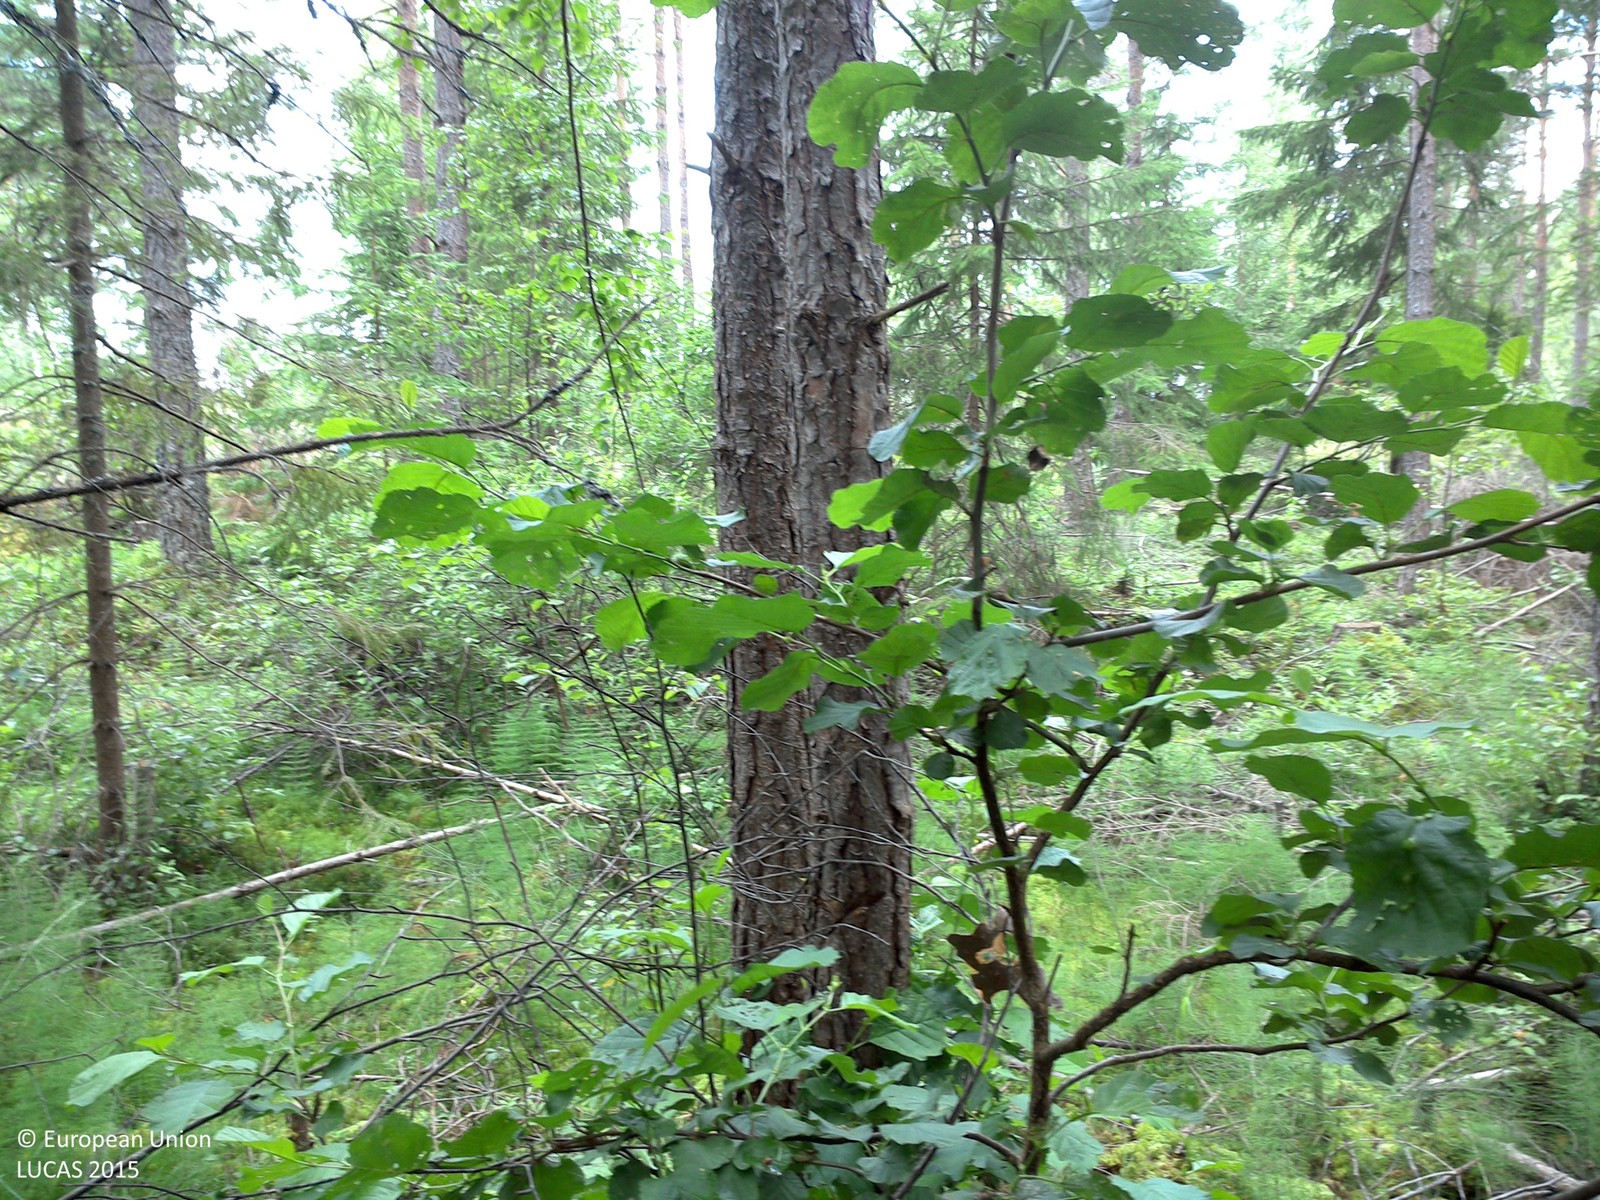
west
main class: Woodland
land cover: Broadleaved woodland
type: mire and swamp forests
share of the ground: 50 - 75 %
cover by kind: broadleaved forest trees 60 %, herbaceous plants 40 %
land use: Forestry
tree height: > 5 m
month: July
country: SE
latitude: 57.9317
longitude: 14.9092
